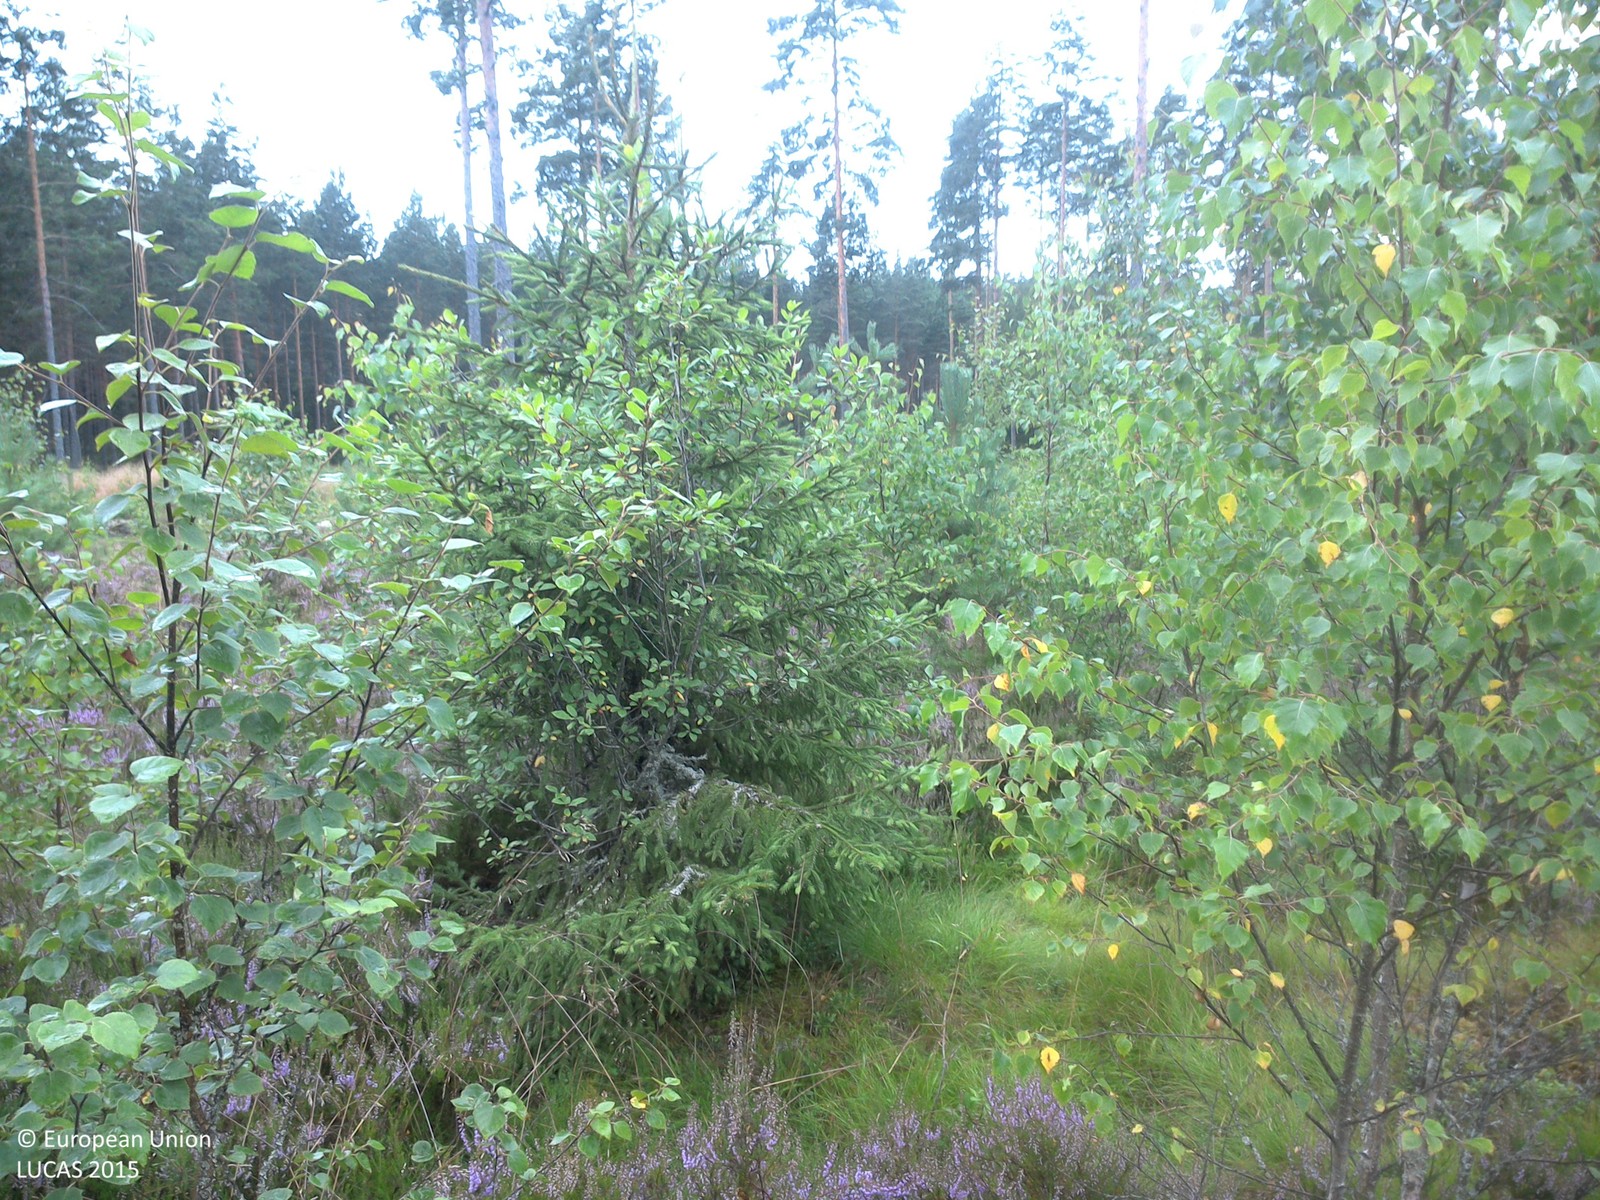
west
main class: Woodland
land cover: Pine dominated mixed woodland
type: boreal forest
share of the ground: 25 - 50 %
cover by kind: herbaceous plants 40 %, coniferous forest trees 25 %, shrubs 20 %, broadleaved forest trees 10 %, lichens and mosses 5 %
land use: Forestry
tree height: < 5 m
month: August
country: SE
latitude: 57.7992
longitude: 15.5316
